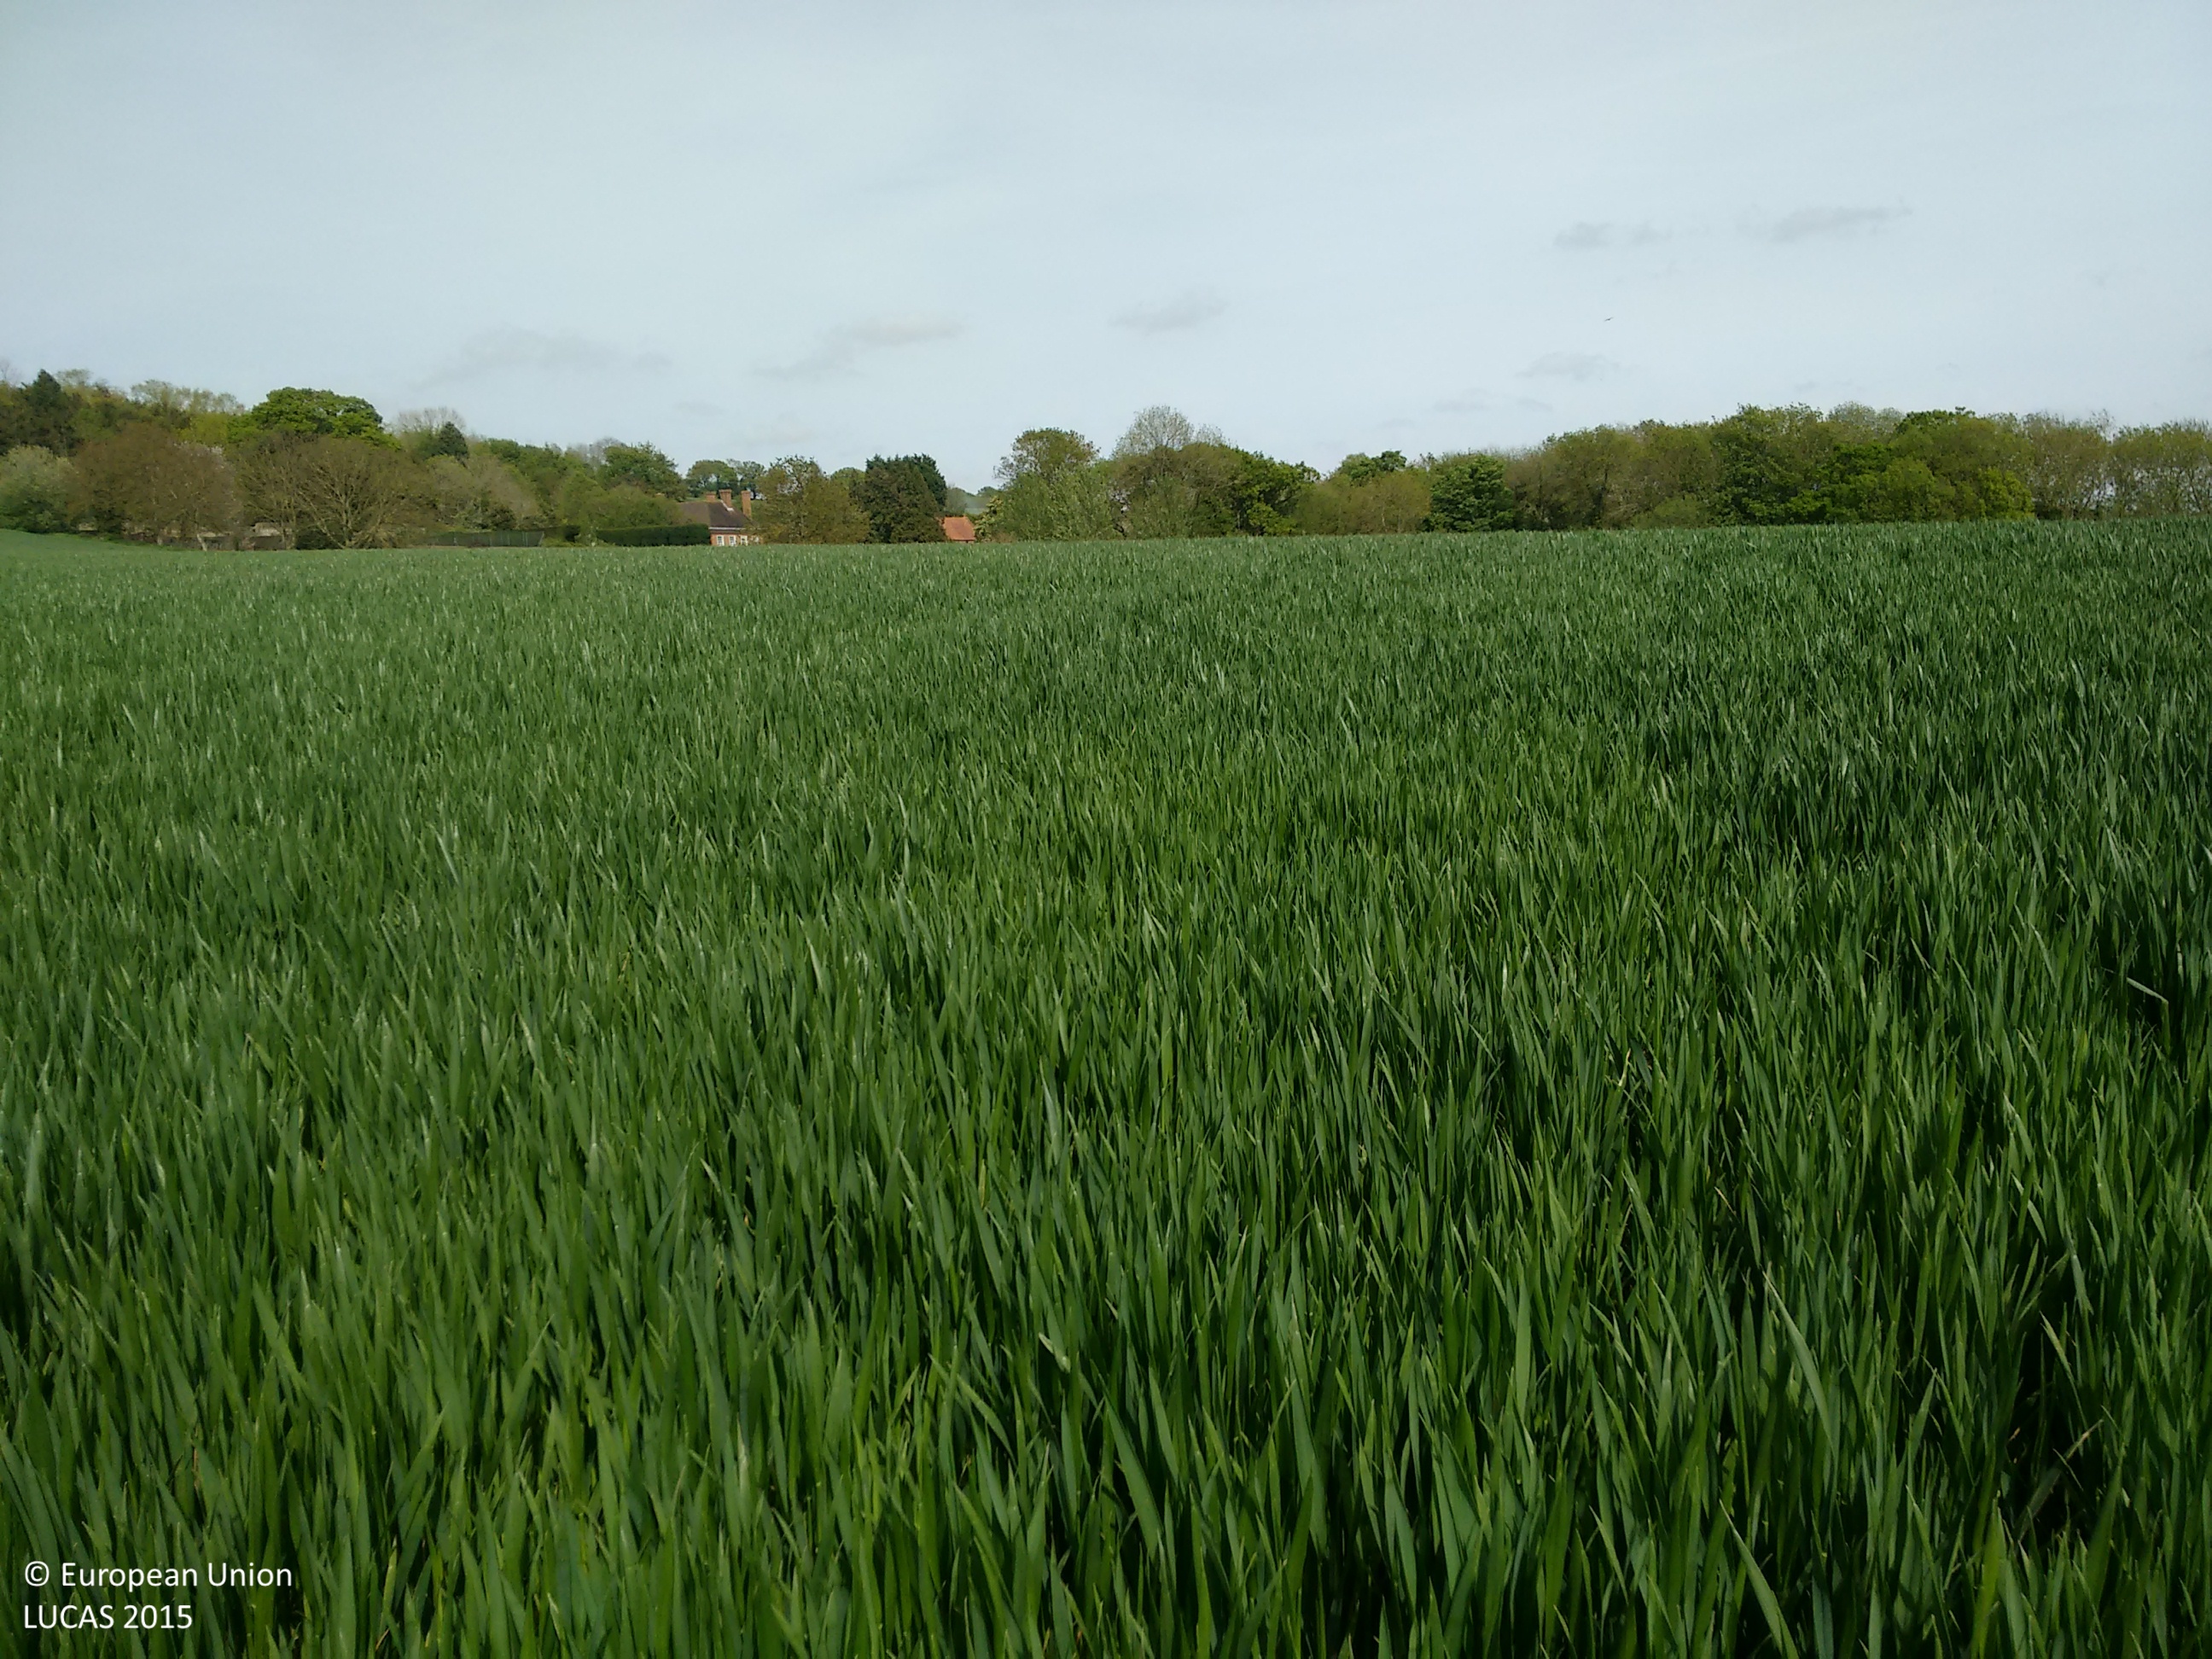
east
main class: Cropland
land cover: Barley
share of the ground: > 75 %
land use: Agriculture (excluding fallow land and kitchen gardens)
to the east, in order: Barley; Tracks; Barley; Grass margins; Fences; Broadleaved woodland
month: May
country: GB
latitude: 51.2310
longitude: 0.4481
